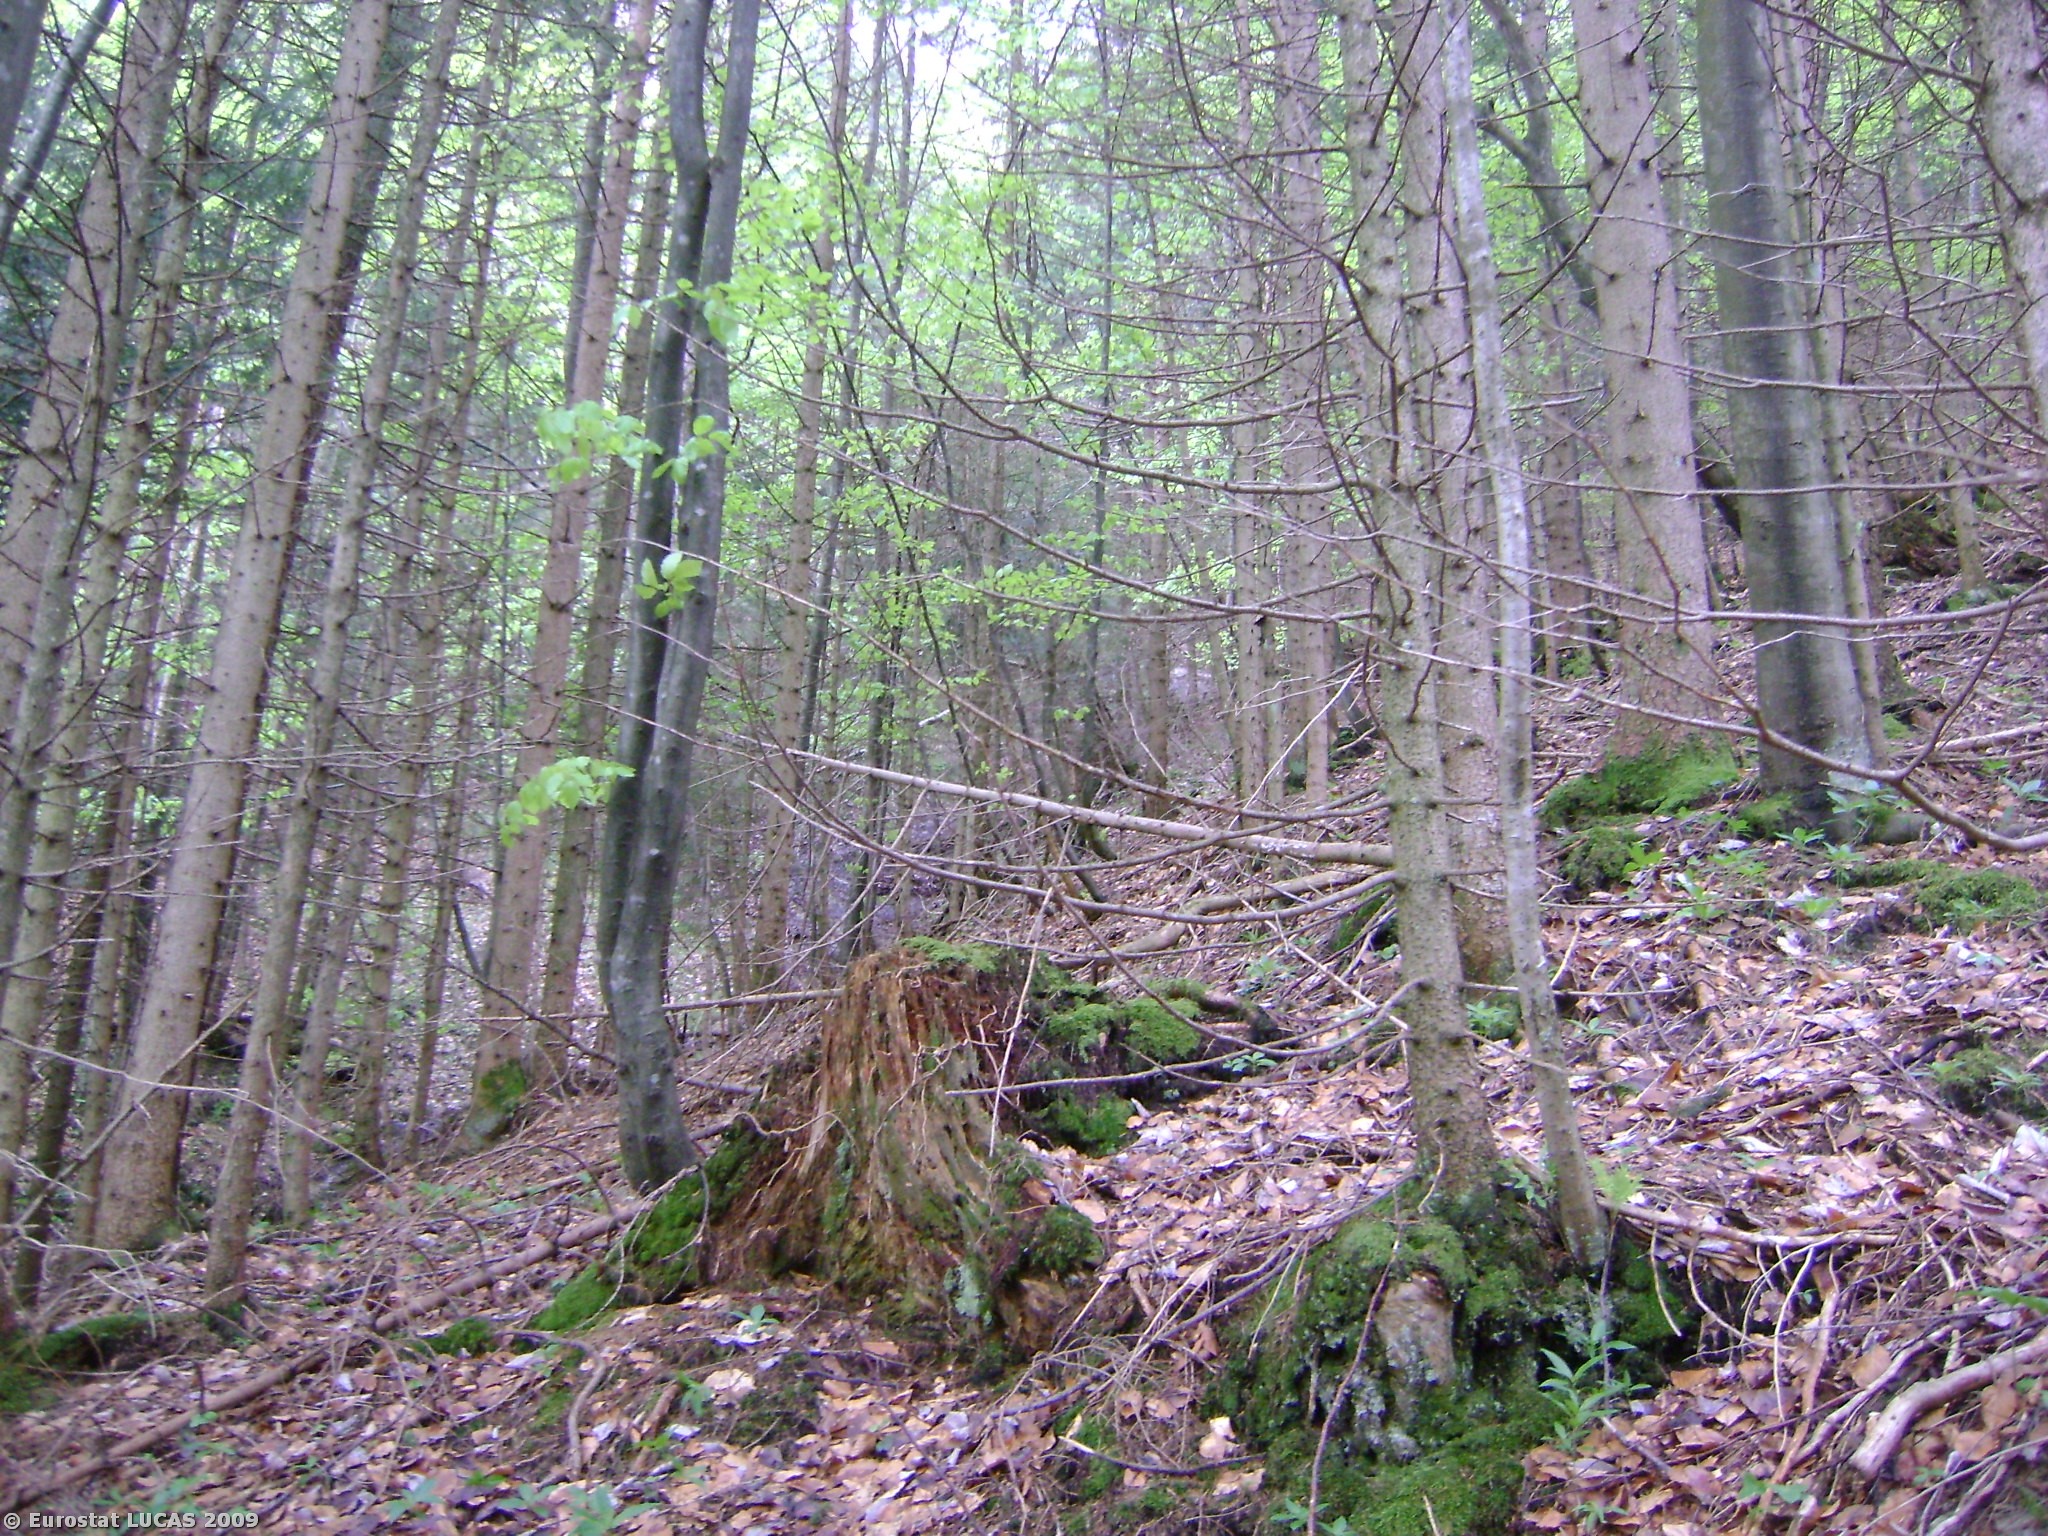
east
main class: Woodland
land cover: Mixed woodland
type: hemiboreal forest and nemoral coniferous forest and mixed broadleaved-coniferous forest
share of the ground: > 75 %
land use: Forestry
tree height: > 5 m
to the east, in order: Mixed woodland; Broadleaved woodland; Mixed woodland; Tracks; Mixed woodland; Paved roads, cycling and walking lanes; Broadleaved woodland
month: May
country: AT
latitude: 47.7984
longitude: 13.2162
